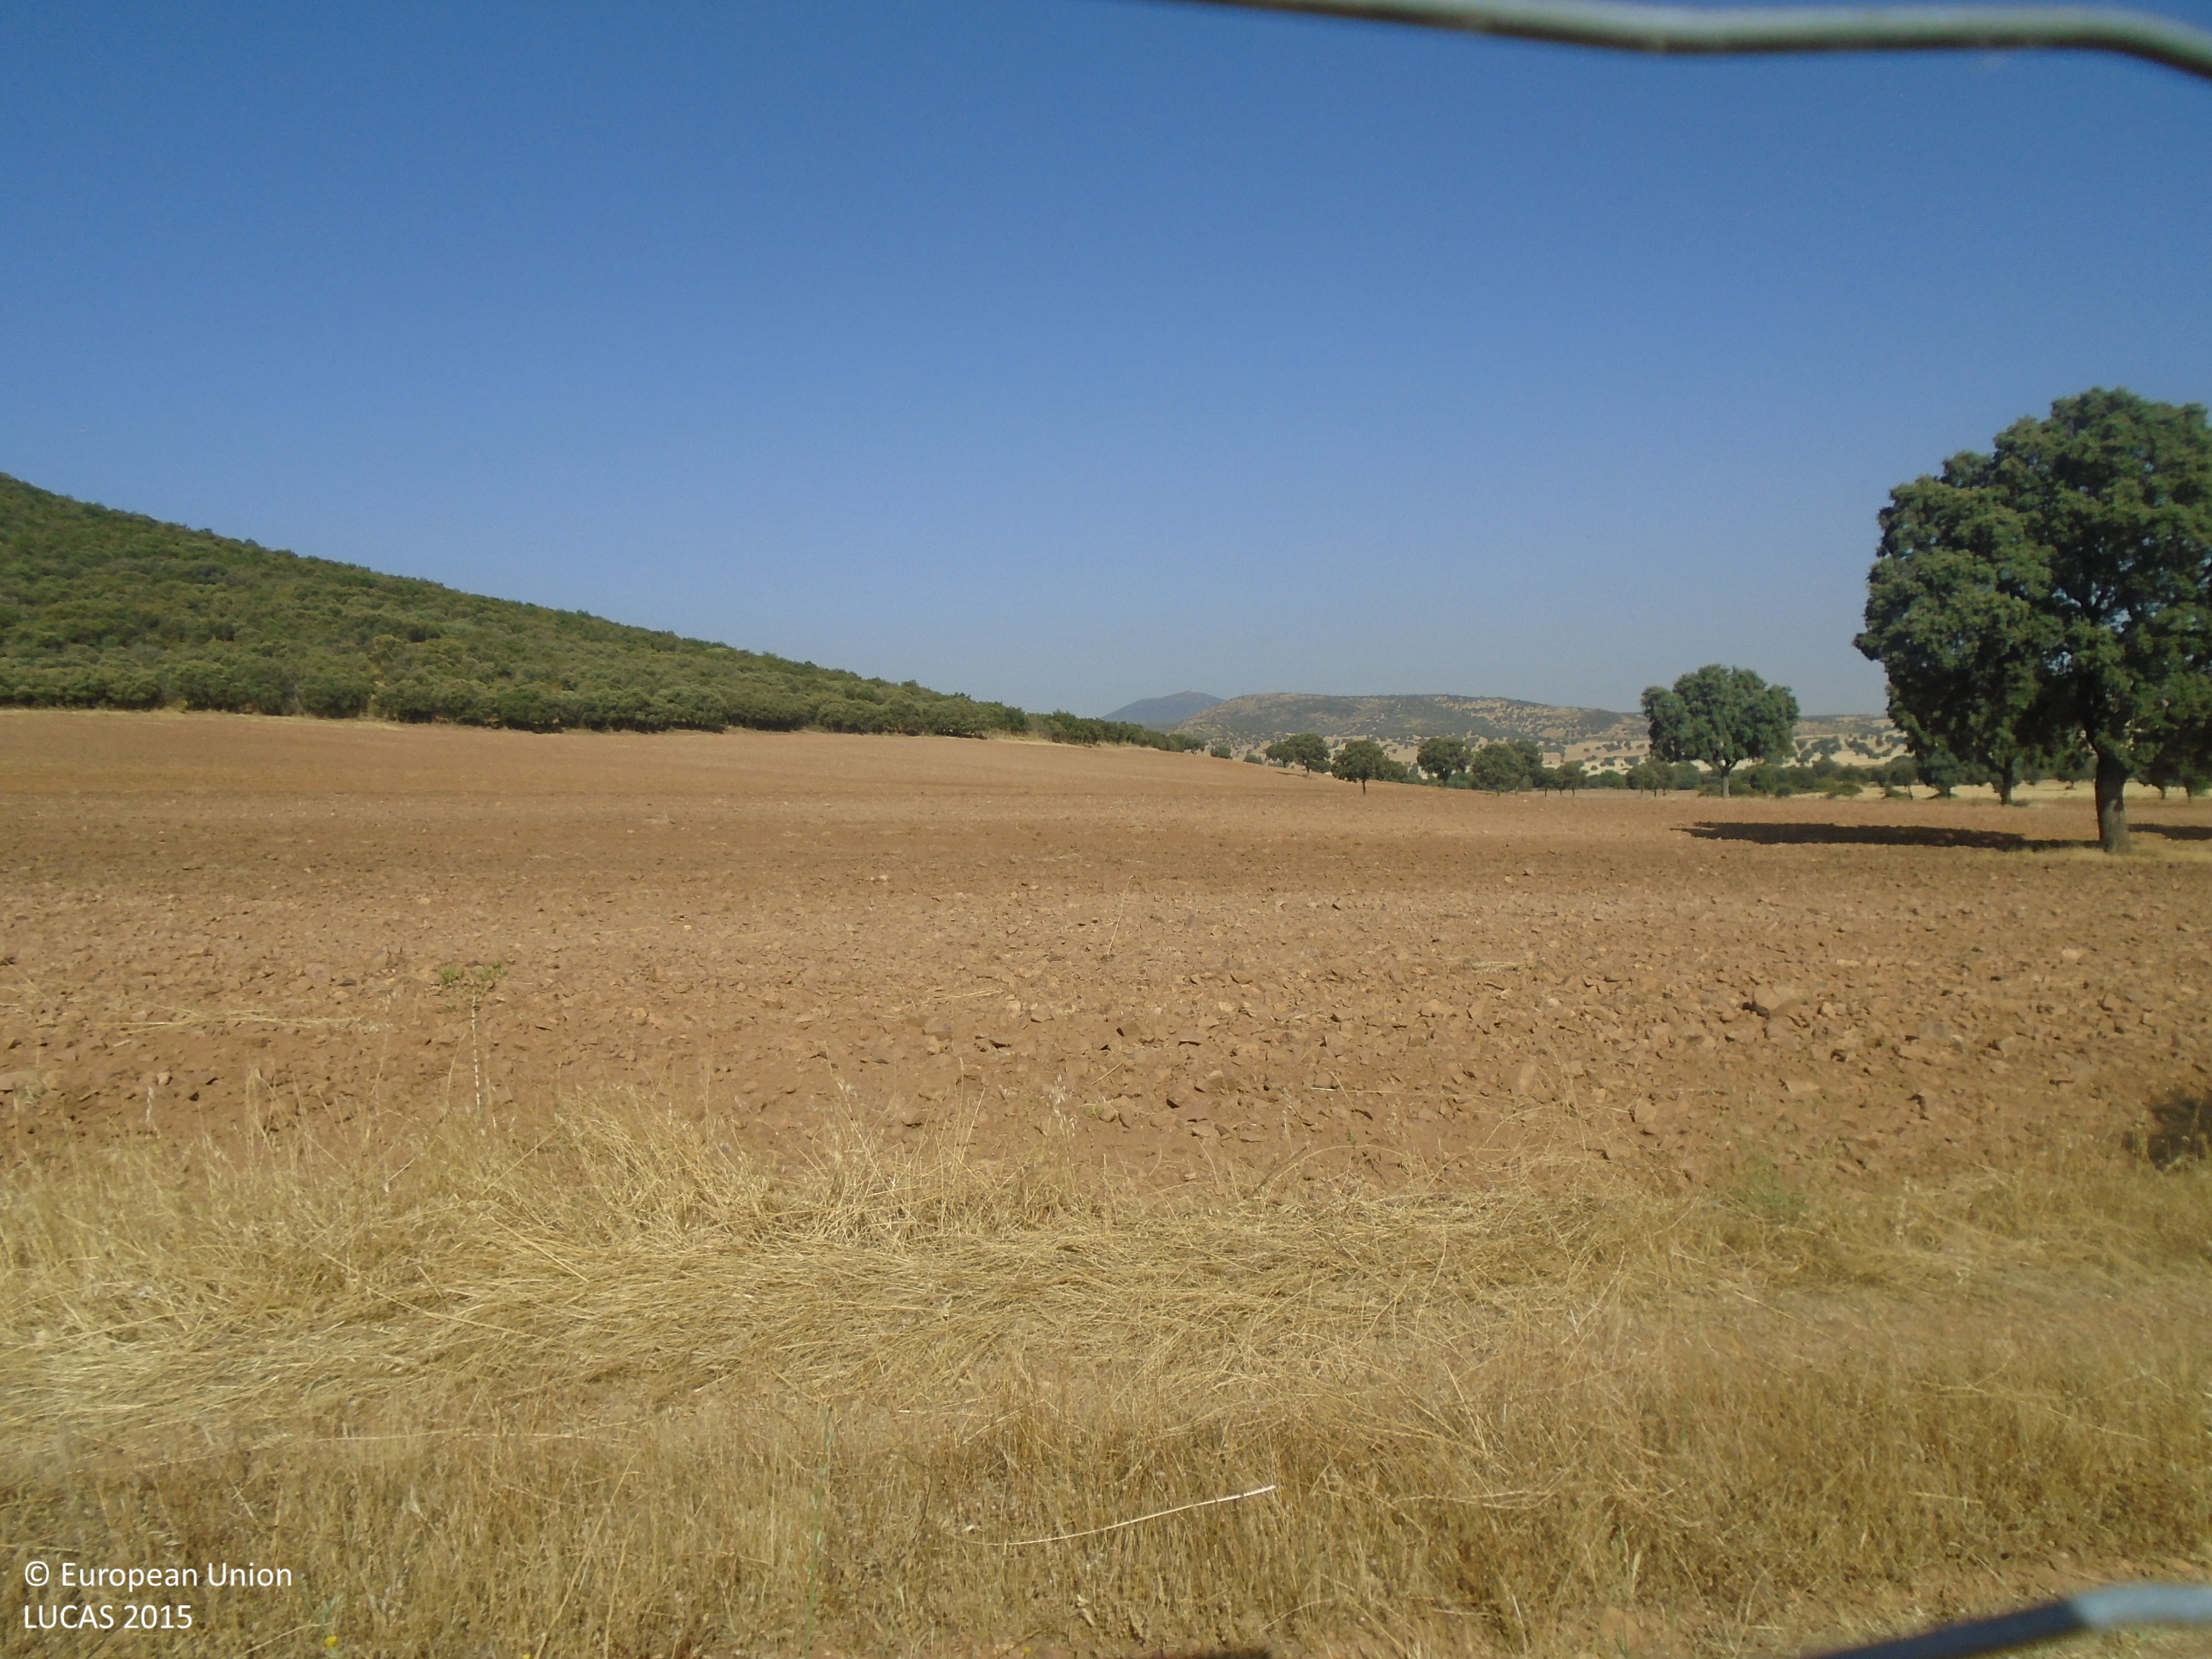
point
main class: Woodland
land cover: Broadleaved woodland
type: broadleaved evergreen forest
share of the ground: > 75 %
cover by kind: broadleaved forest trees 90 %, shrubs 10 %
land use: Semi-natural and natural areas not in use
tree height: > 5 m
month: July
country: ES
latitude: 39.3021
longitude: -3.6941
